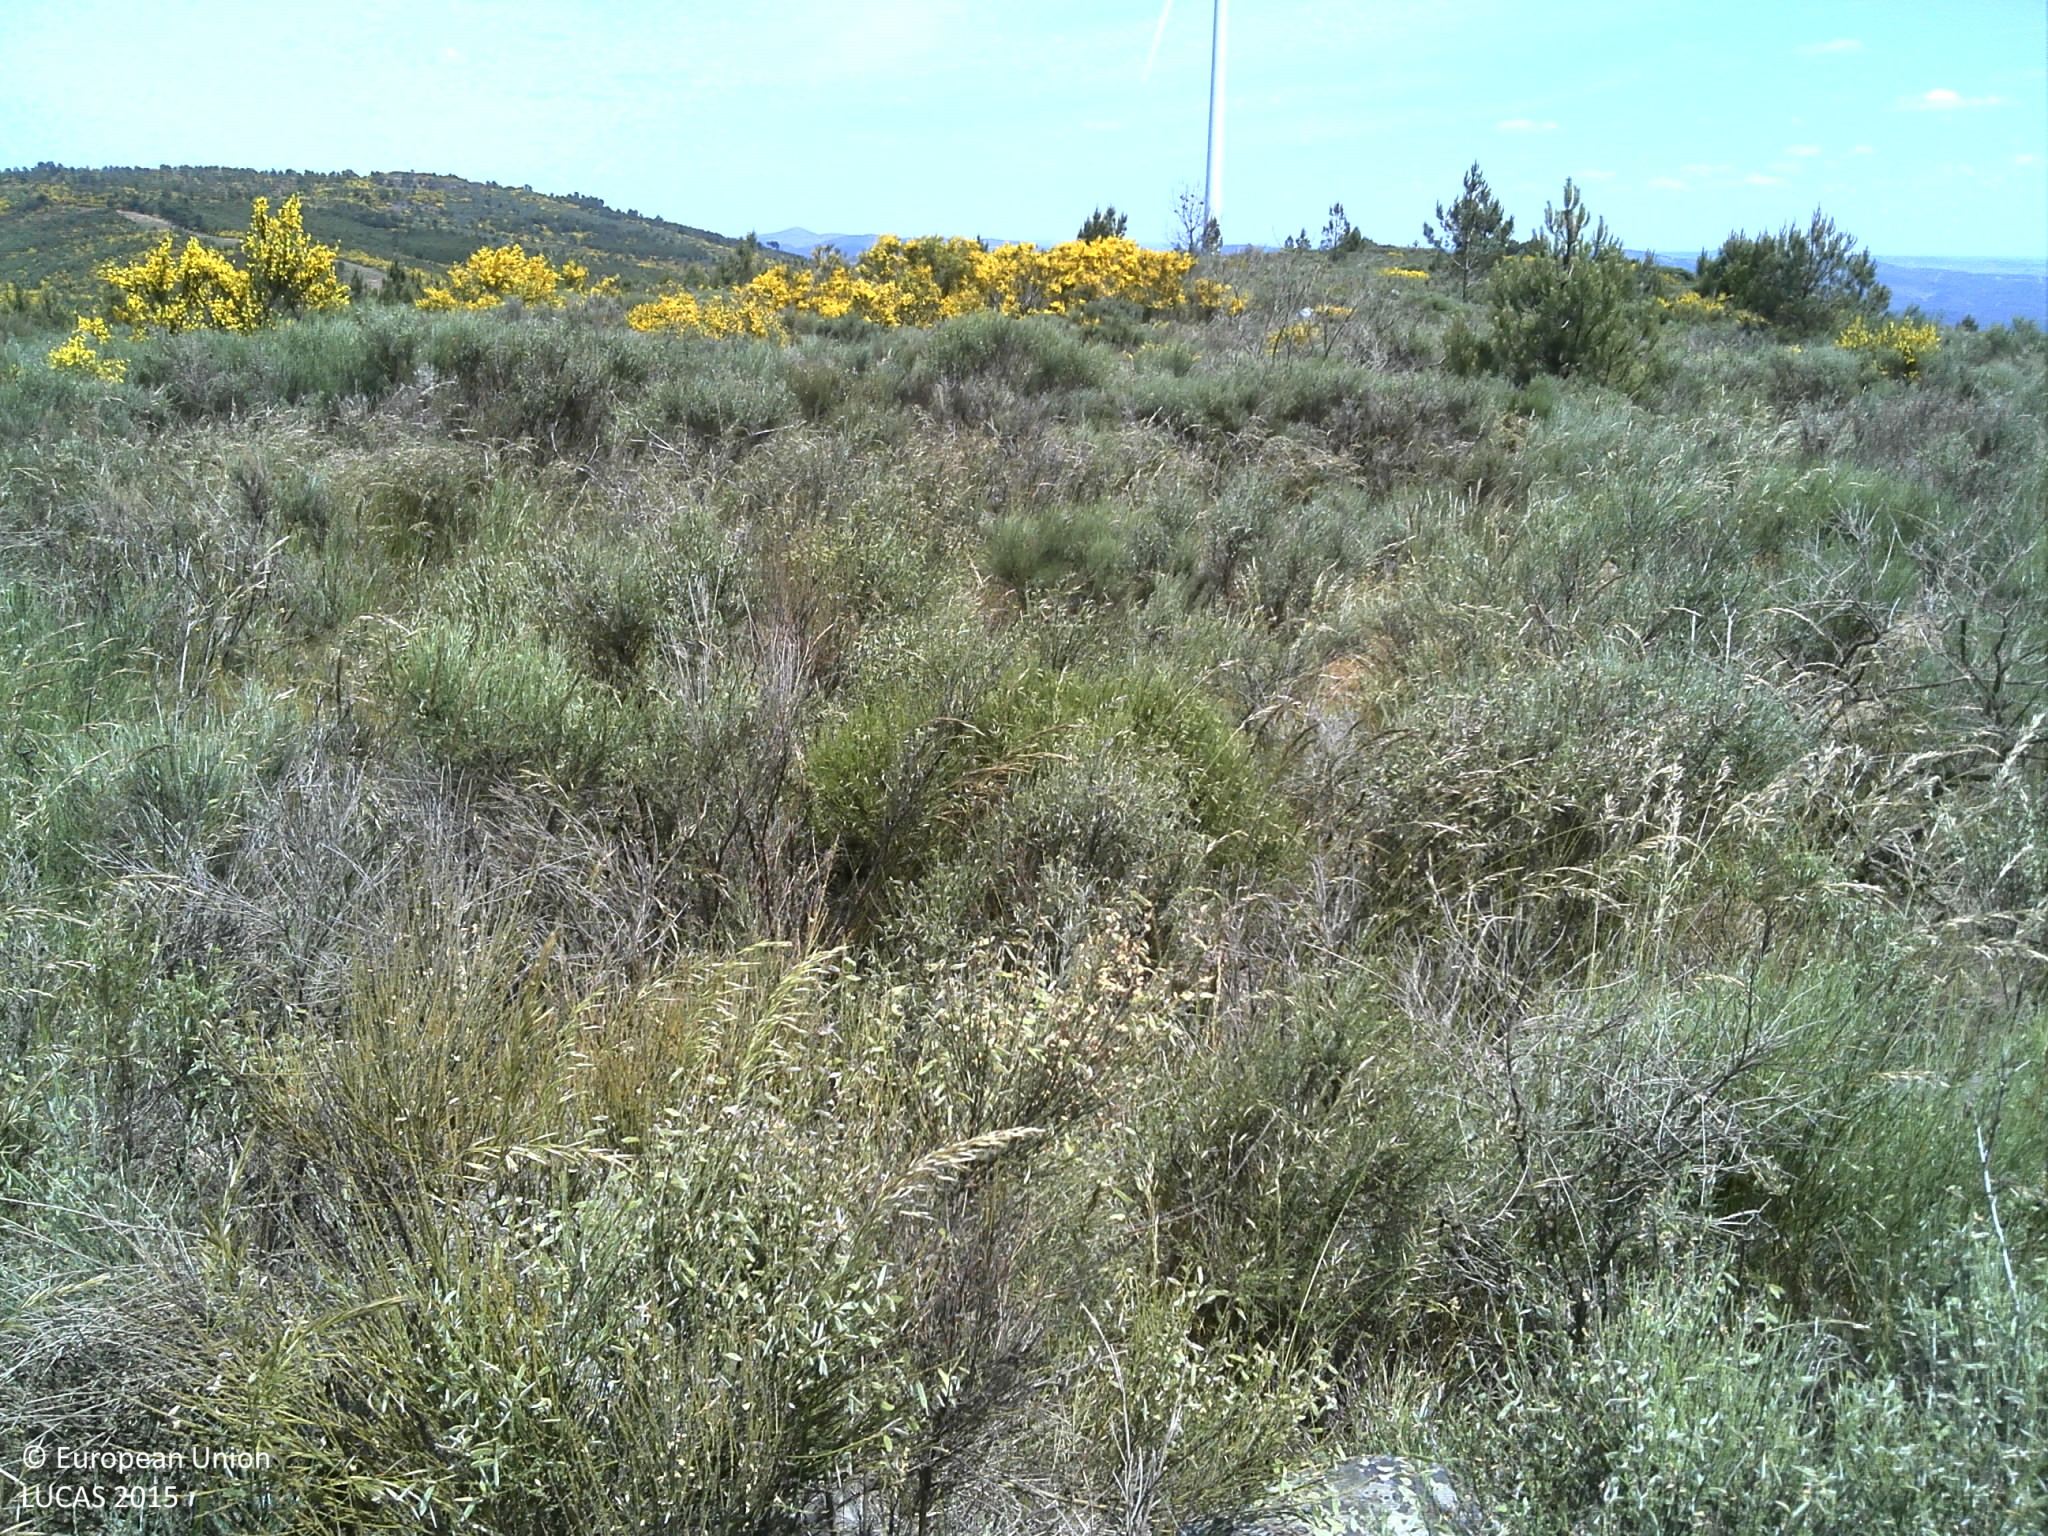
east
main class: Shrubland
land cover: Shrubland with sparse tree cover
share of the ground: > 75 %
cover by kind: shrubs 90 %, coniferous forest trees 5 %, consolidated bare surface 5 %
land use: Forestry
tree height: < 5 m
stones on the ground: < 10 %
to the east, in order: Shrubland with sparse tree cover; Shrubland without tree cover; Tracks; Shrubland with sparse tree cover
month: May
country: PT
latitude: 41.1720
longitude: -6.9751
